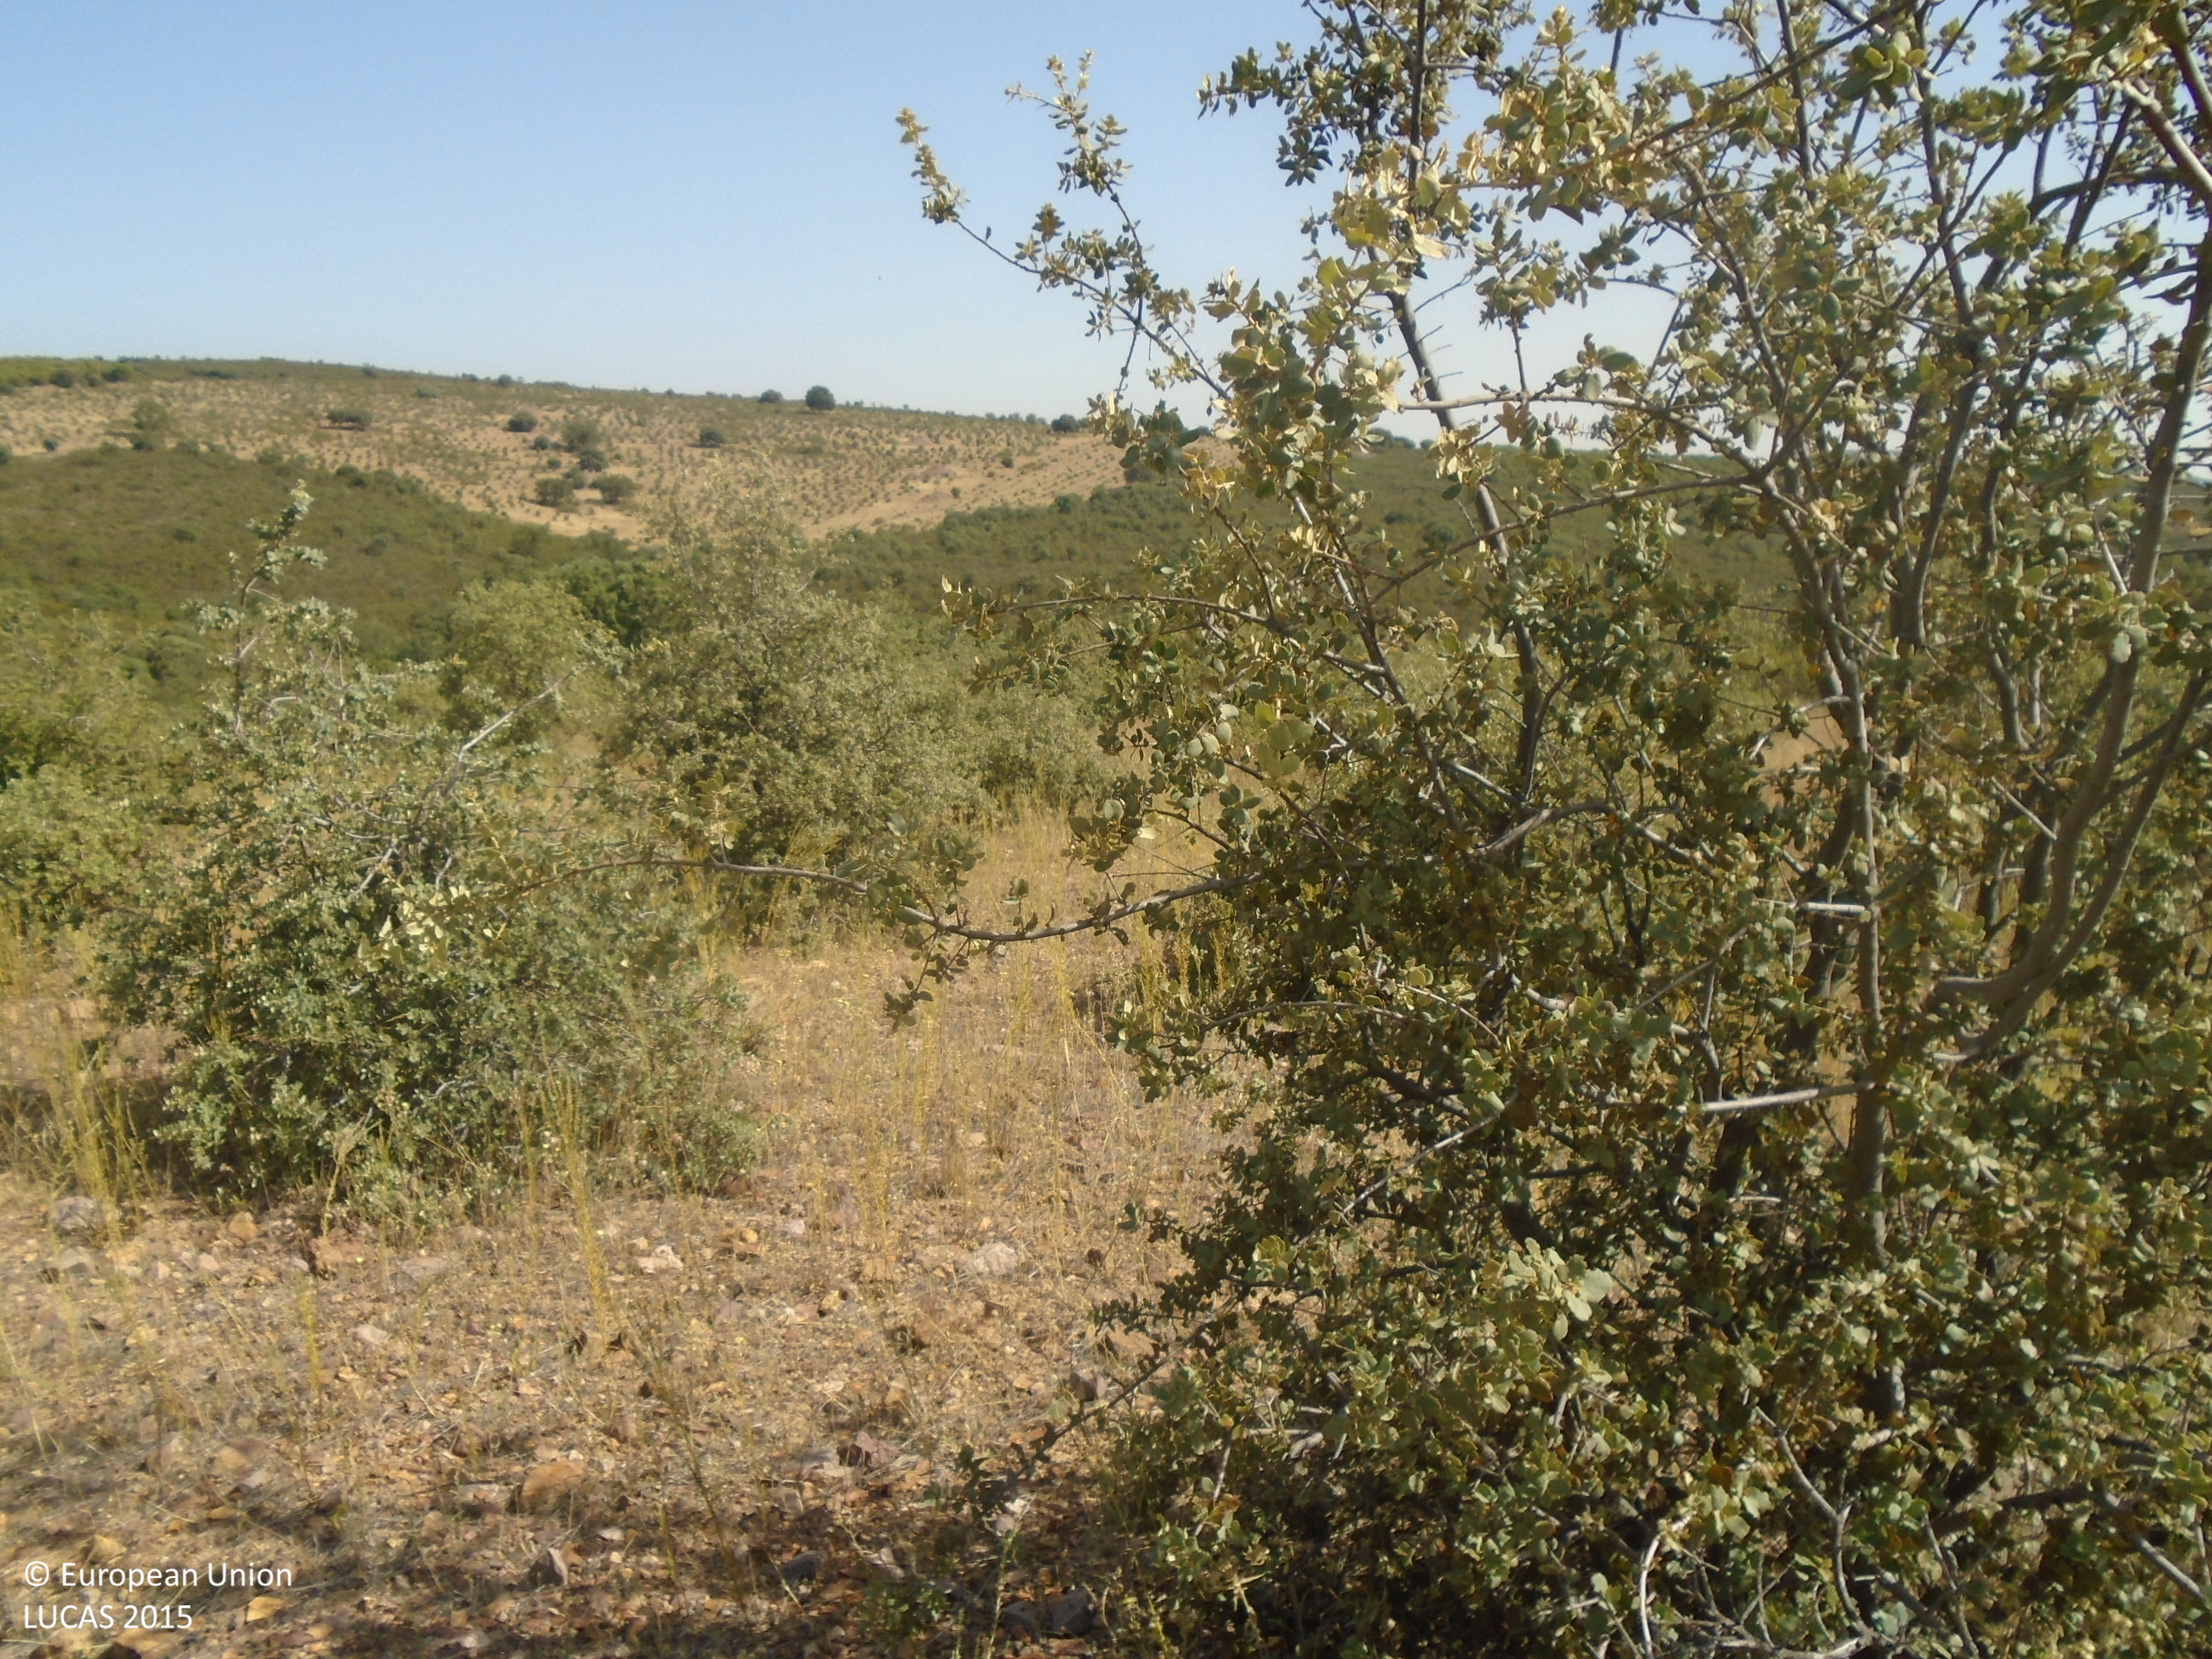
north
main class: Woodland
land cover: Broadleaved woodland
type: broadleaved evergreen forest
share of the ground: 10 - 25 %
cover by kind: herbaceous plants 75 %, broadleaved forest trees 25 %
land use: Forestry
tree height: < 5 m
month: July
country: ES
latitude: 39.2995
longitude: -4.0928
